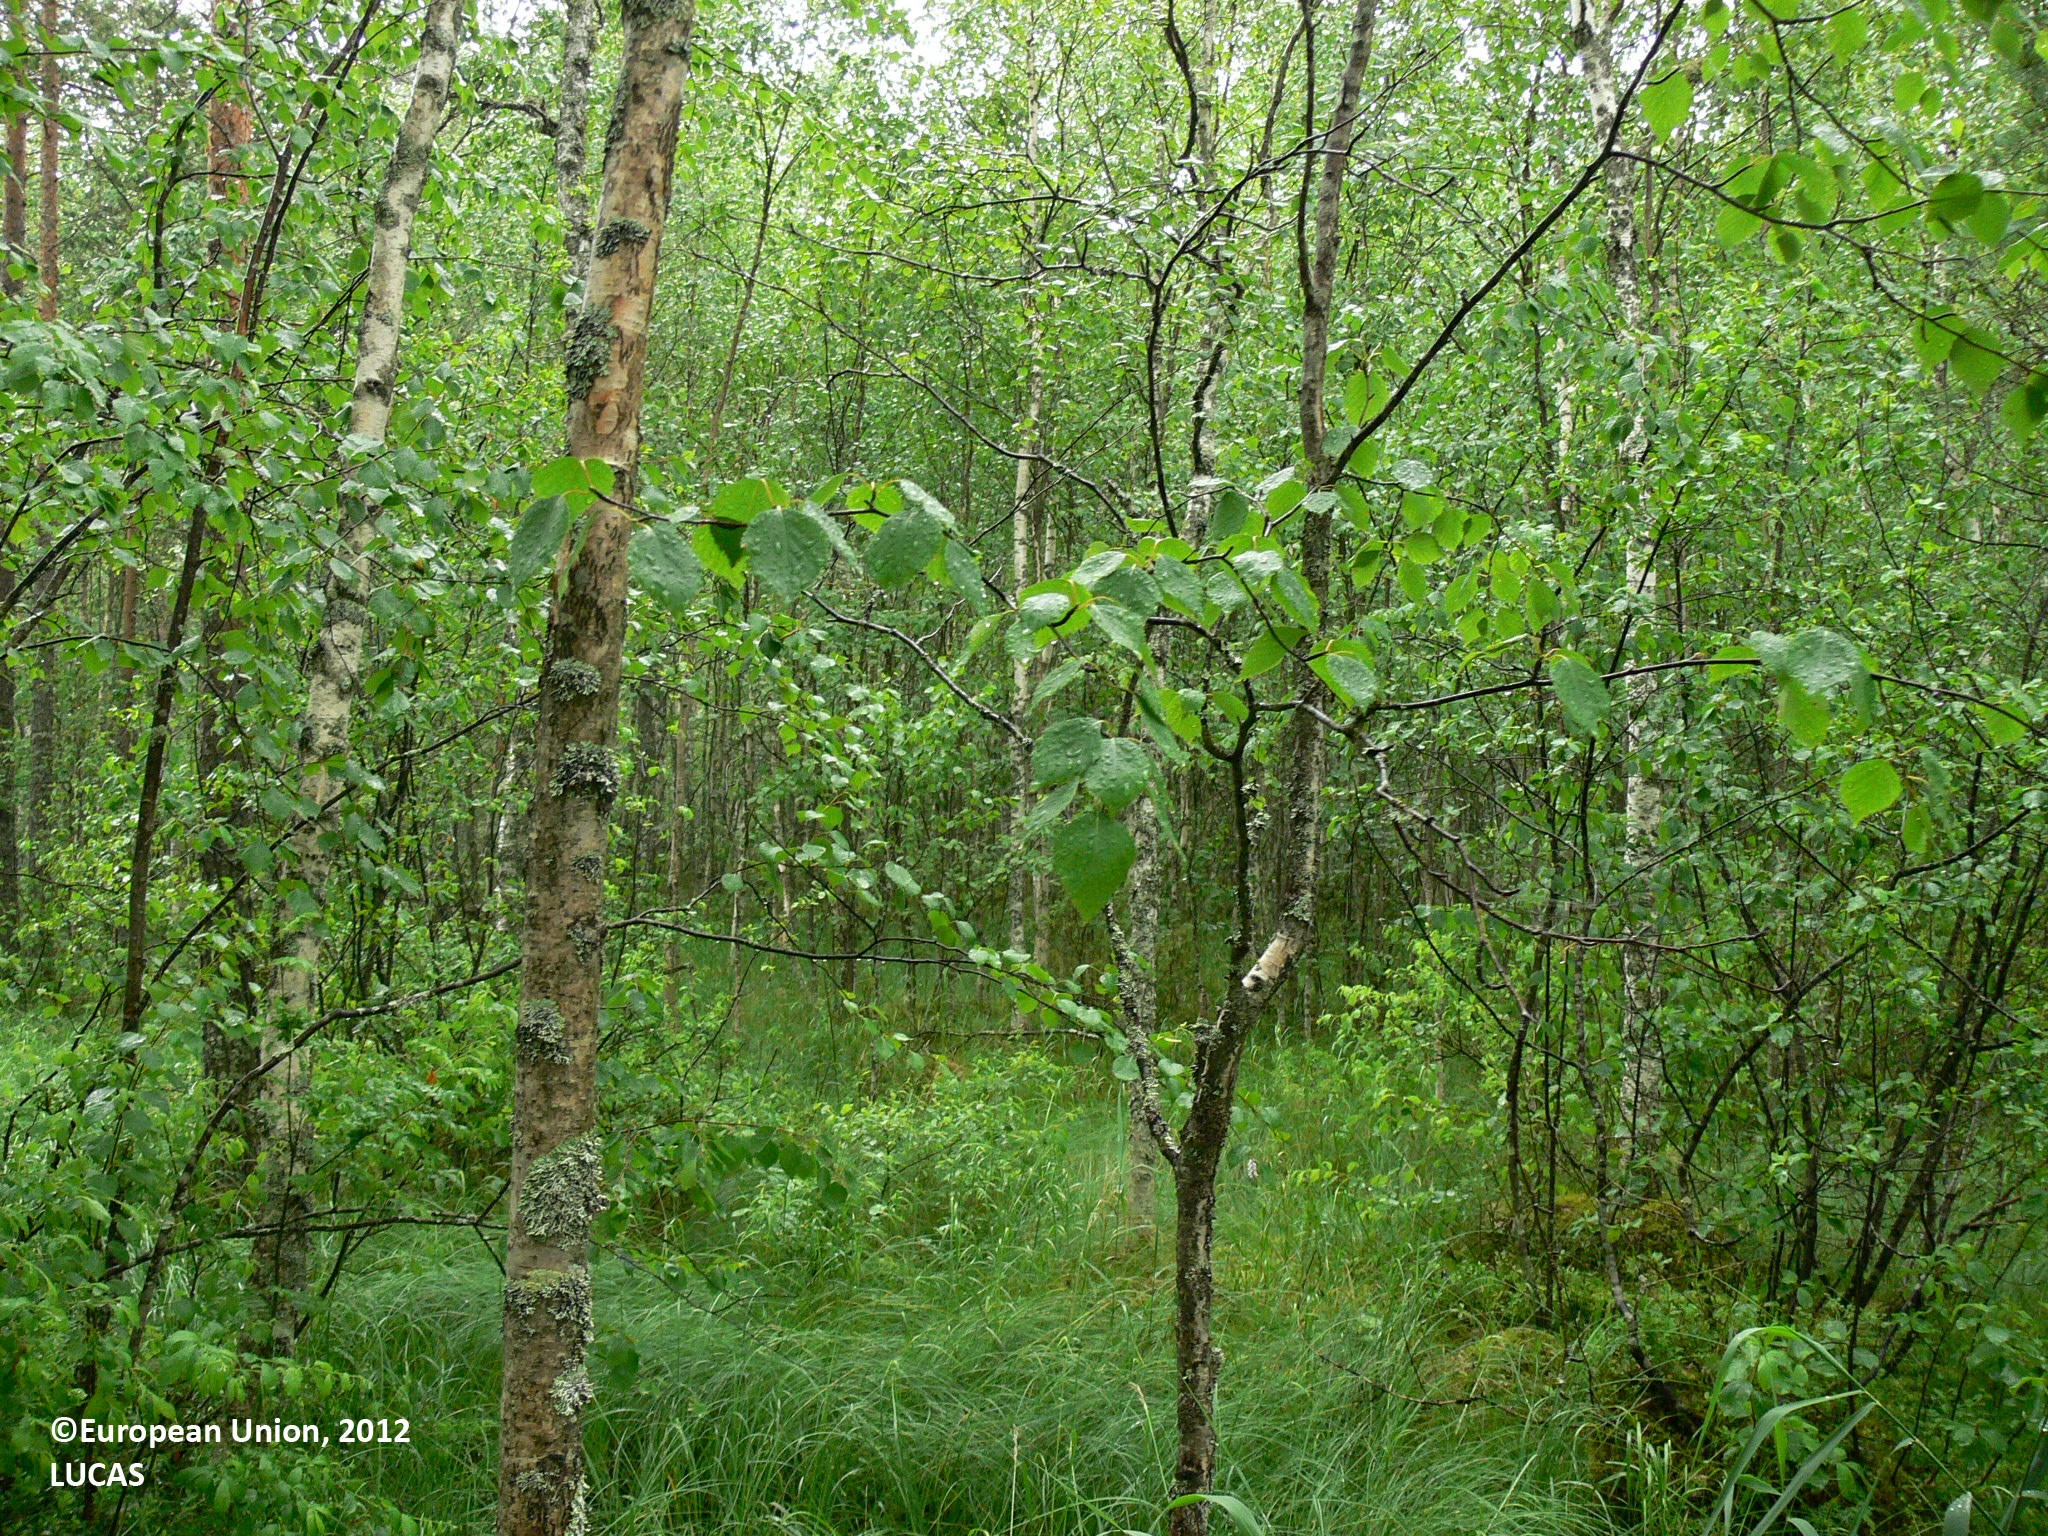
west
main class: Woodland
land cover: Pine dominated mixed woodland
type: boreal forest
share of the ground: > 75 %
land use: Semi-natural and natural areas not in use
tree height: > 5 m
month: July
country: FI
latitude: 63.1052
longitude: 30.7971
